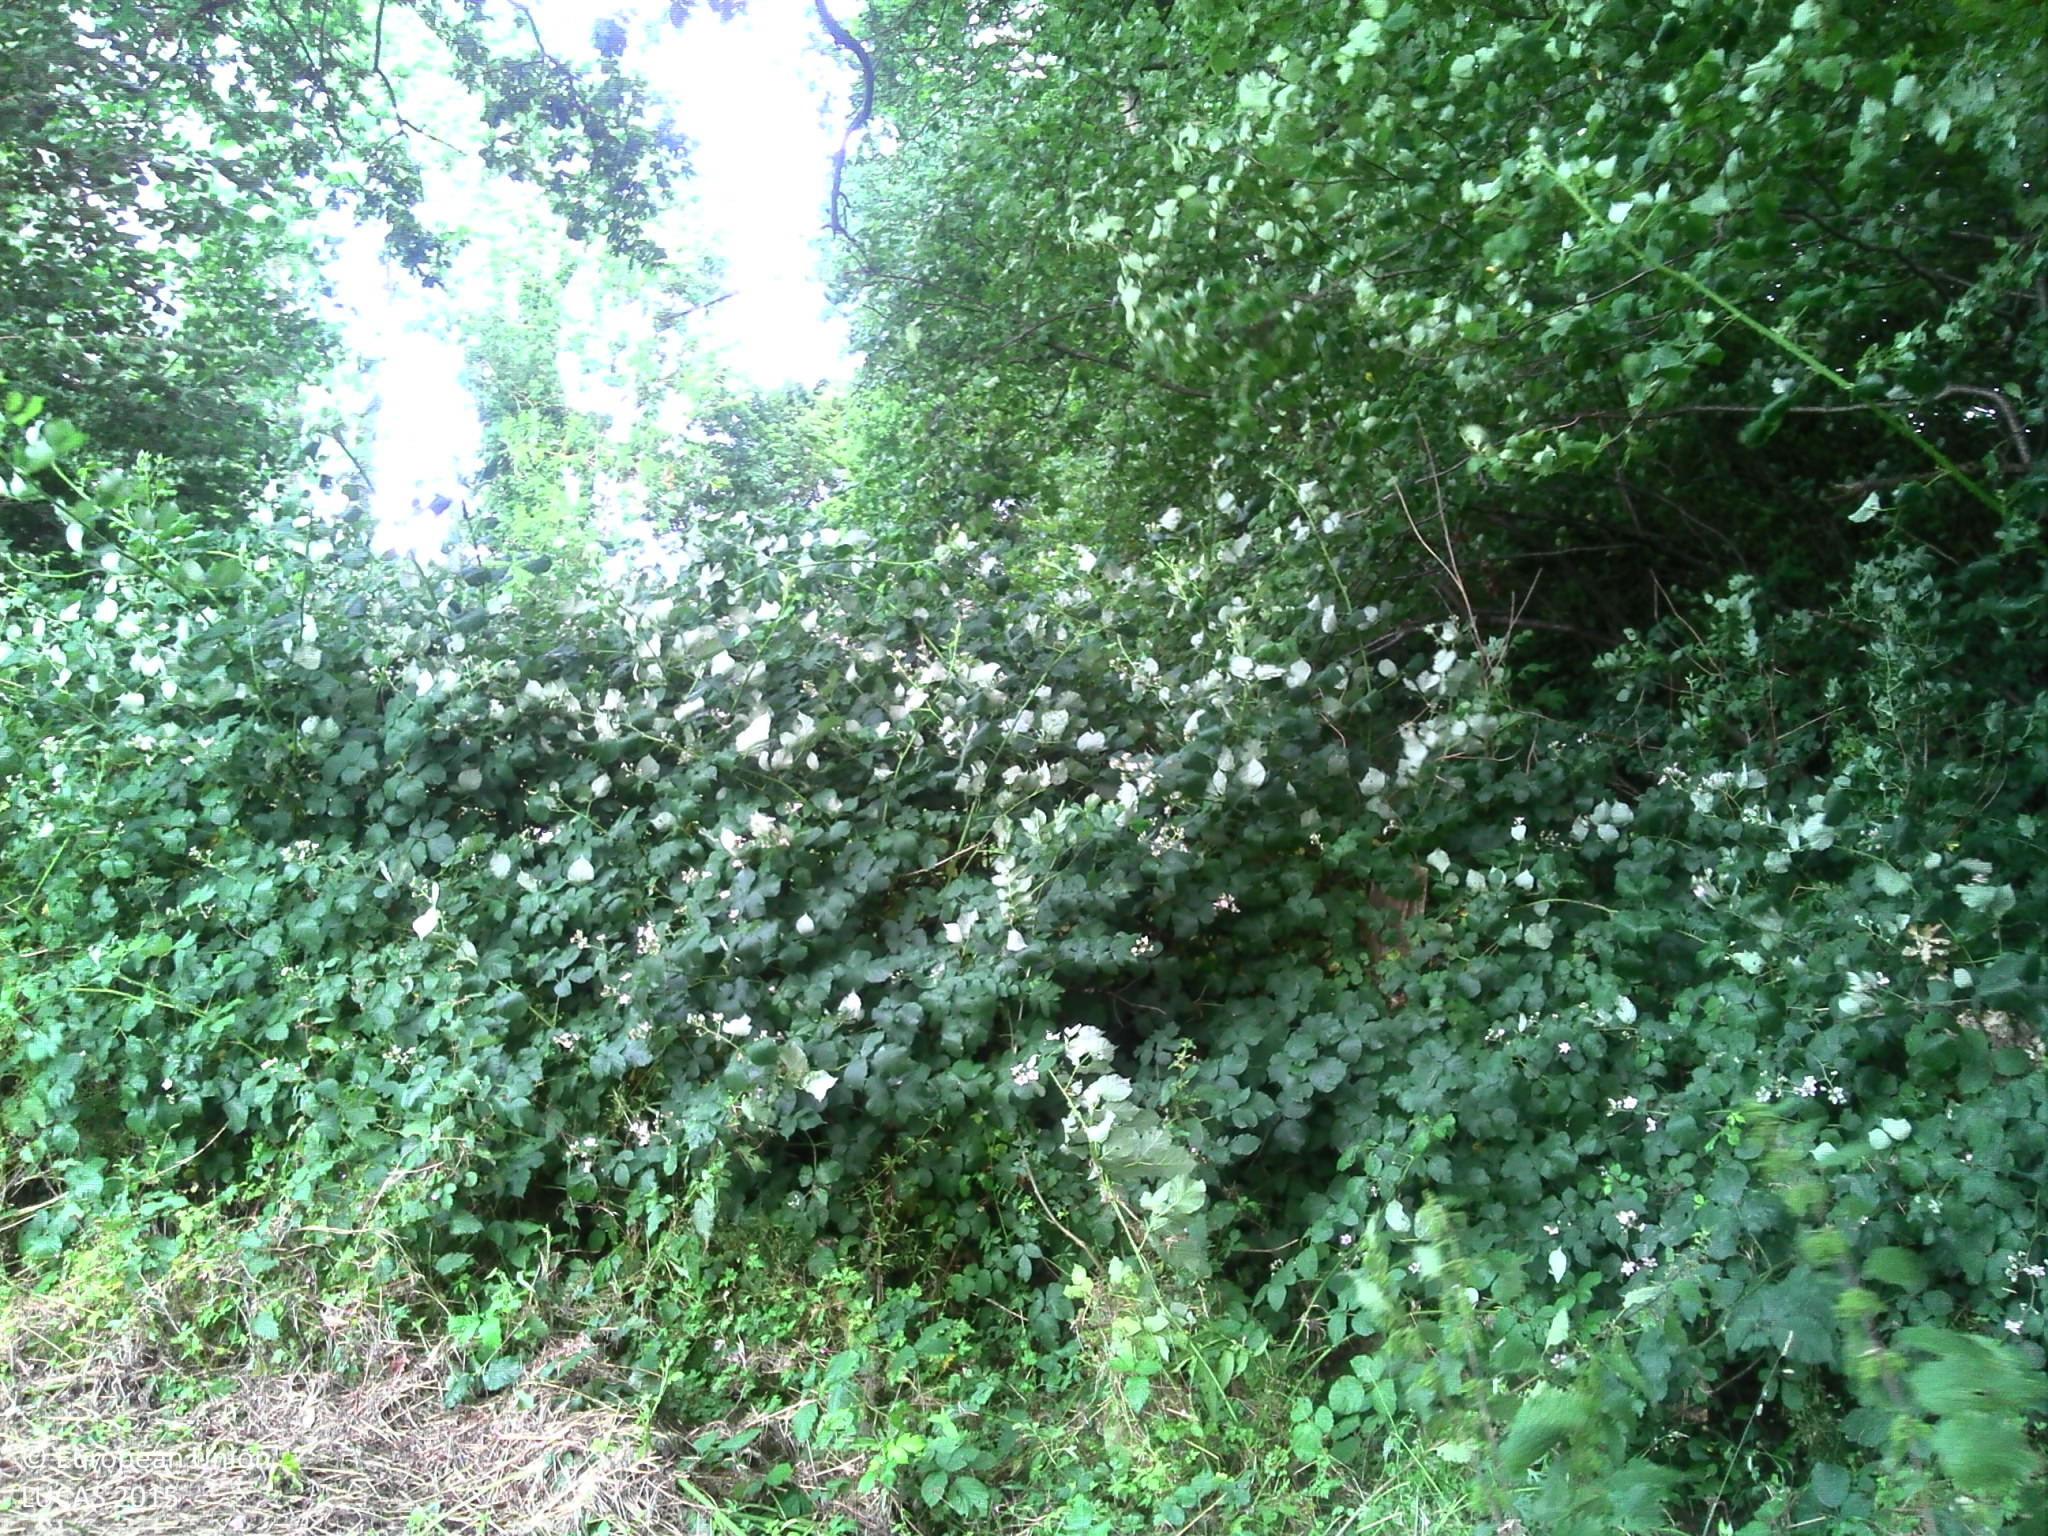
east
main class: Grassland
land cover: Grassland without tree/shrub cover
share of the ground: > 75 %
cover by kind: herbaceous plants 100 %
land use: Agriculture (excluding fallow land and kitchen gardens)
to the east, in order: Grassland without tree/shrub cover; Abandoned hedges; Grassland without tree/shrub cover; Abandoned hedges; Grassland without tree/shrub cover
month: July
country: FR
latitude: 49.2396
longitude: 0.4549
